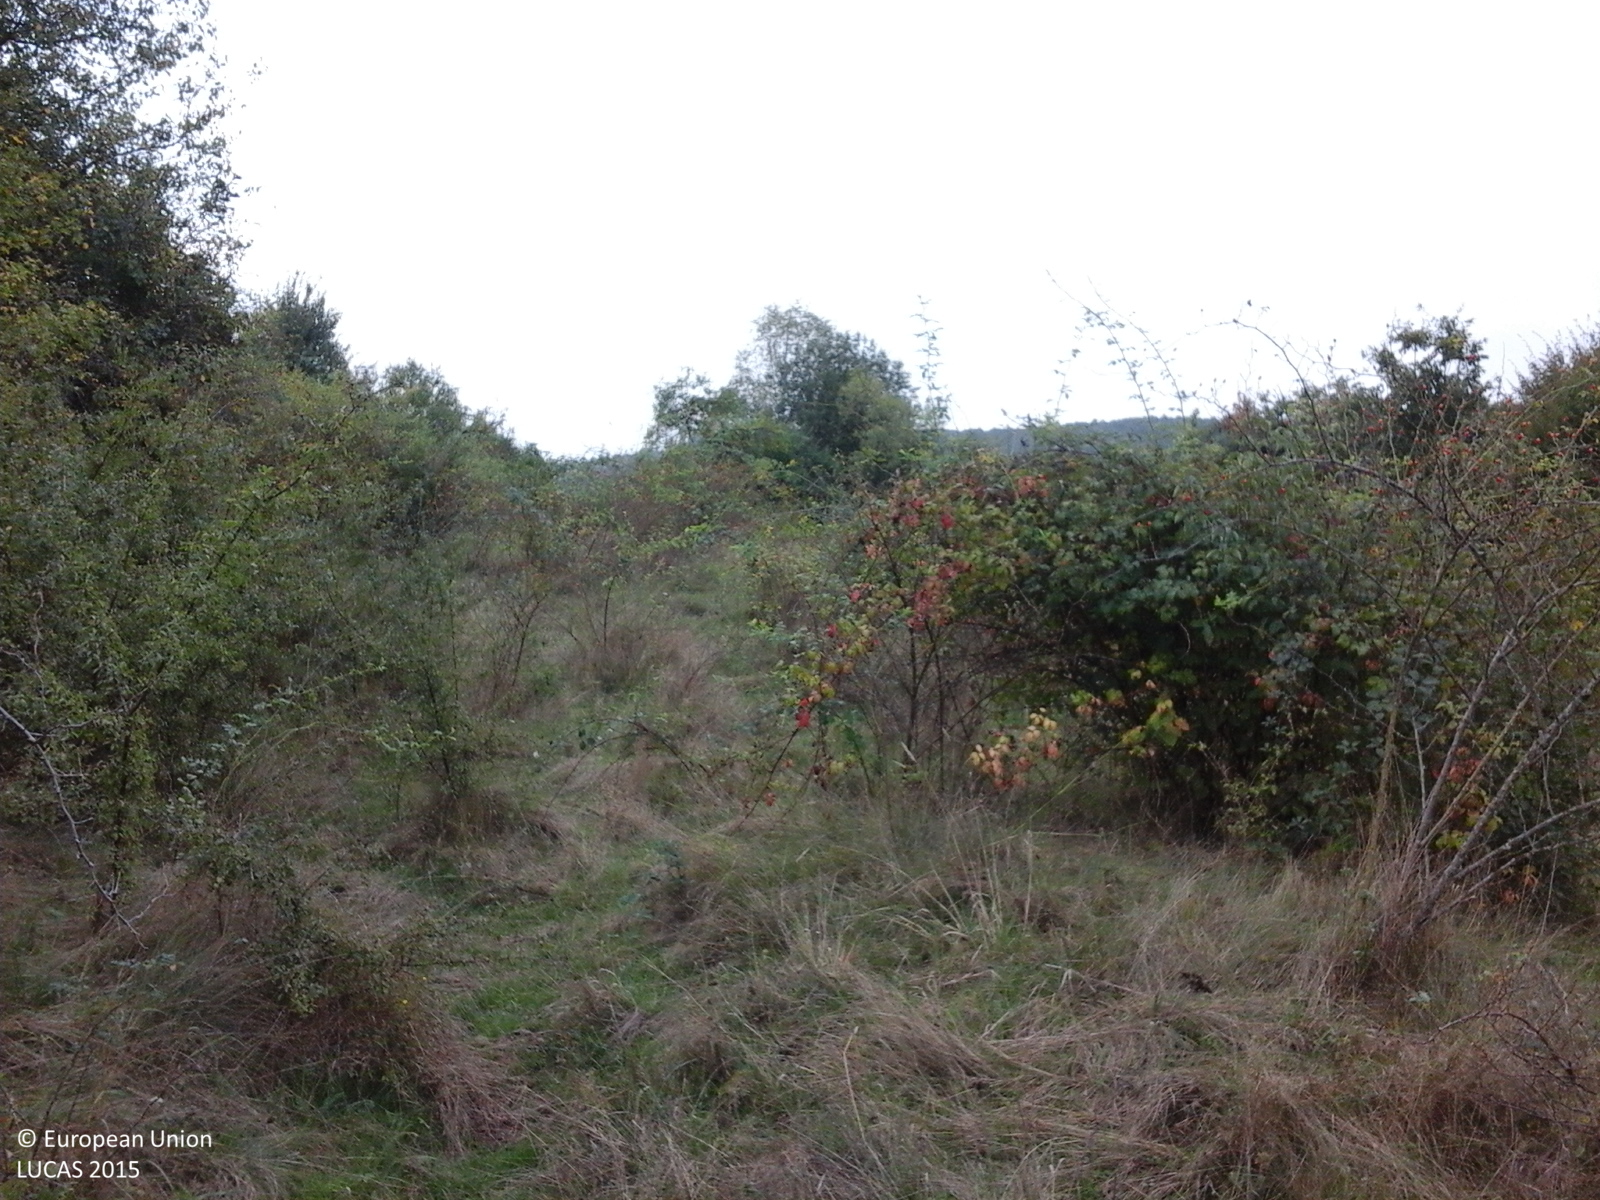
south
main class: Shrubland
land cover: Shrubland with sparse tree cover
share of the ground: > 75 %
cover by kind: herbaceous plants 55 %, shrubs 40 %, broadleaved forest trees 5 %
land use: Fallow land
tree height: < 5 m
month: September
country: RO
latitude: 45.9254
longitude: 22.0209
